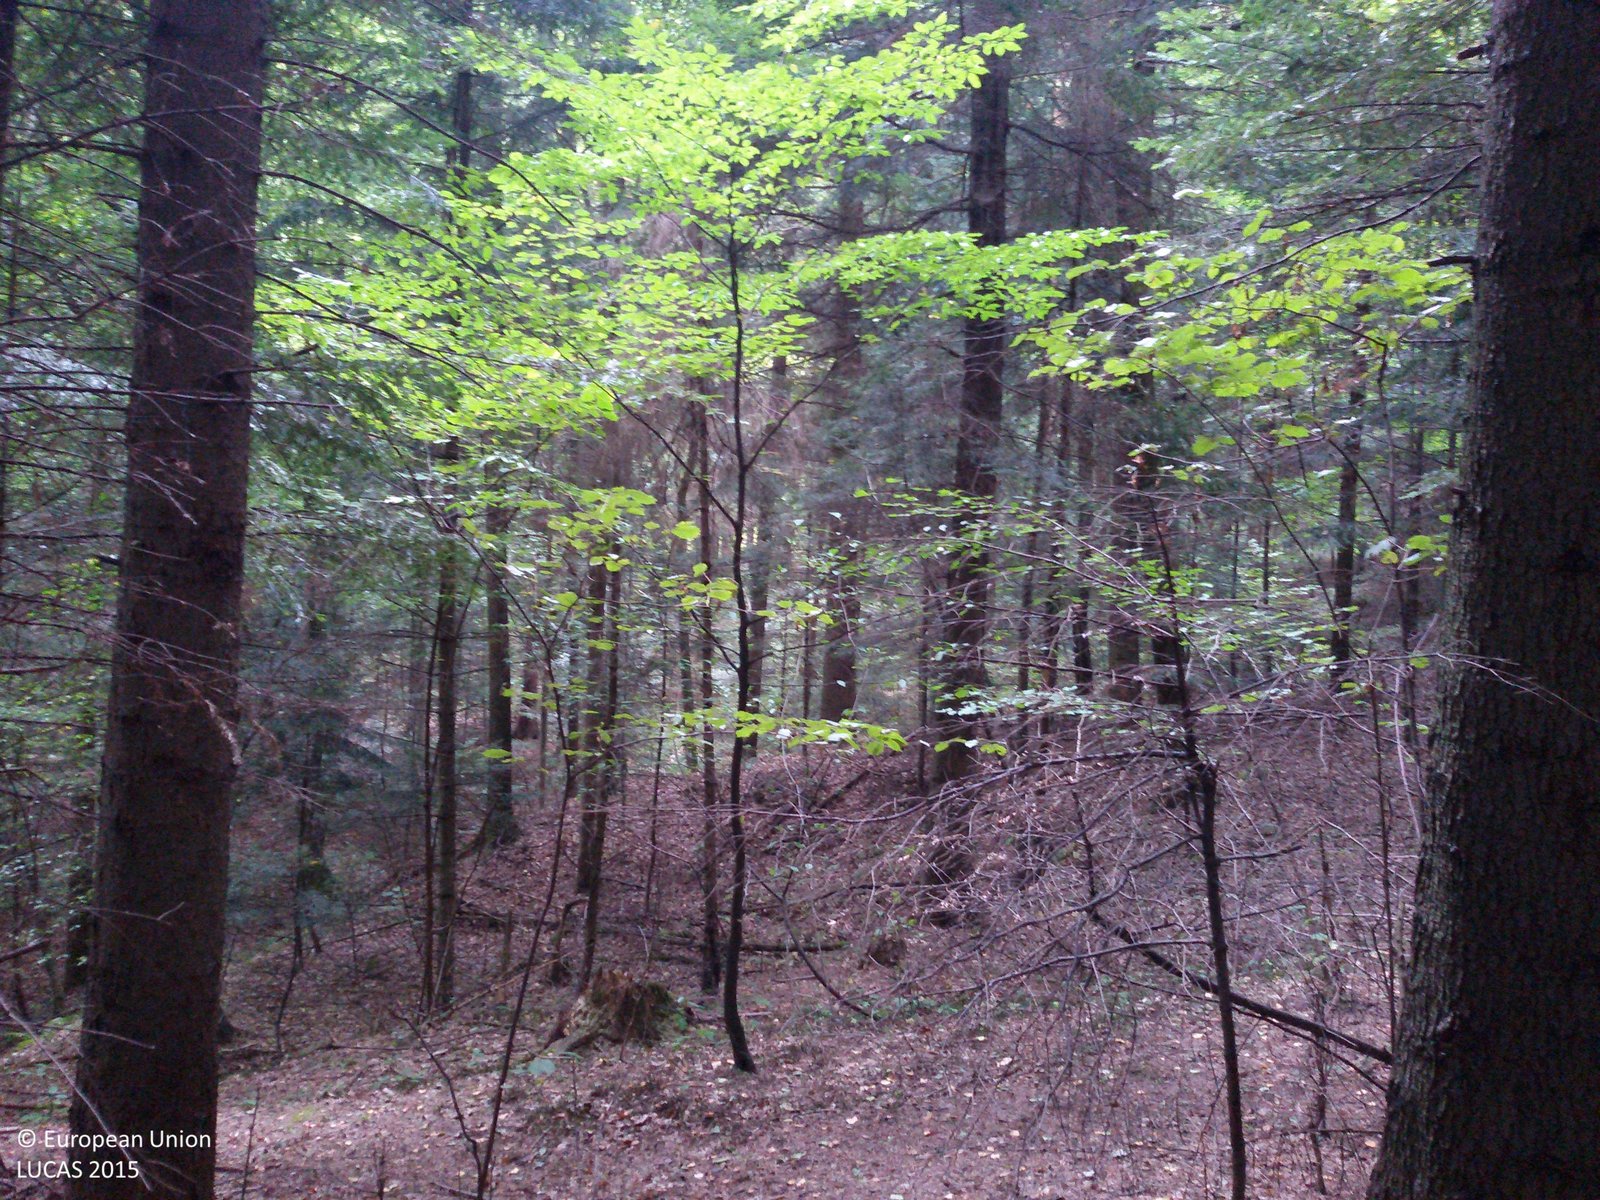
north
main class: Woodland
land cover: Spruce dominated coniferous woodland
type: hemiboreal forest and nemoral coniferous forest and mixed broadleaved-coniferous forest
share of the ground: > 75 %
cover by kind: coniferous forest trees 85 %, broadleaved forest trees 10 %, shrubs 5 %
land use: Forestry
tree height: > 5 m
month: September
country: PL
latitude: 49.8265
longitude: 21.2367
